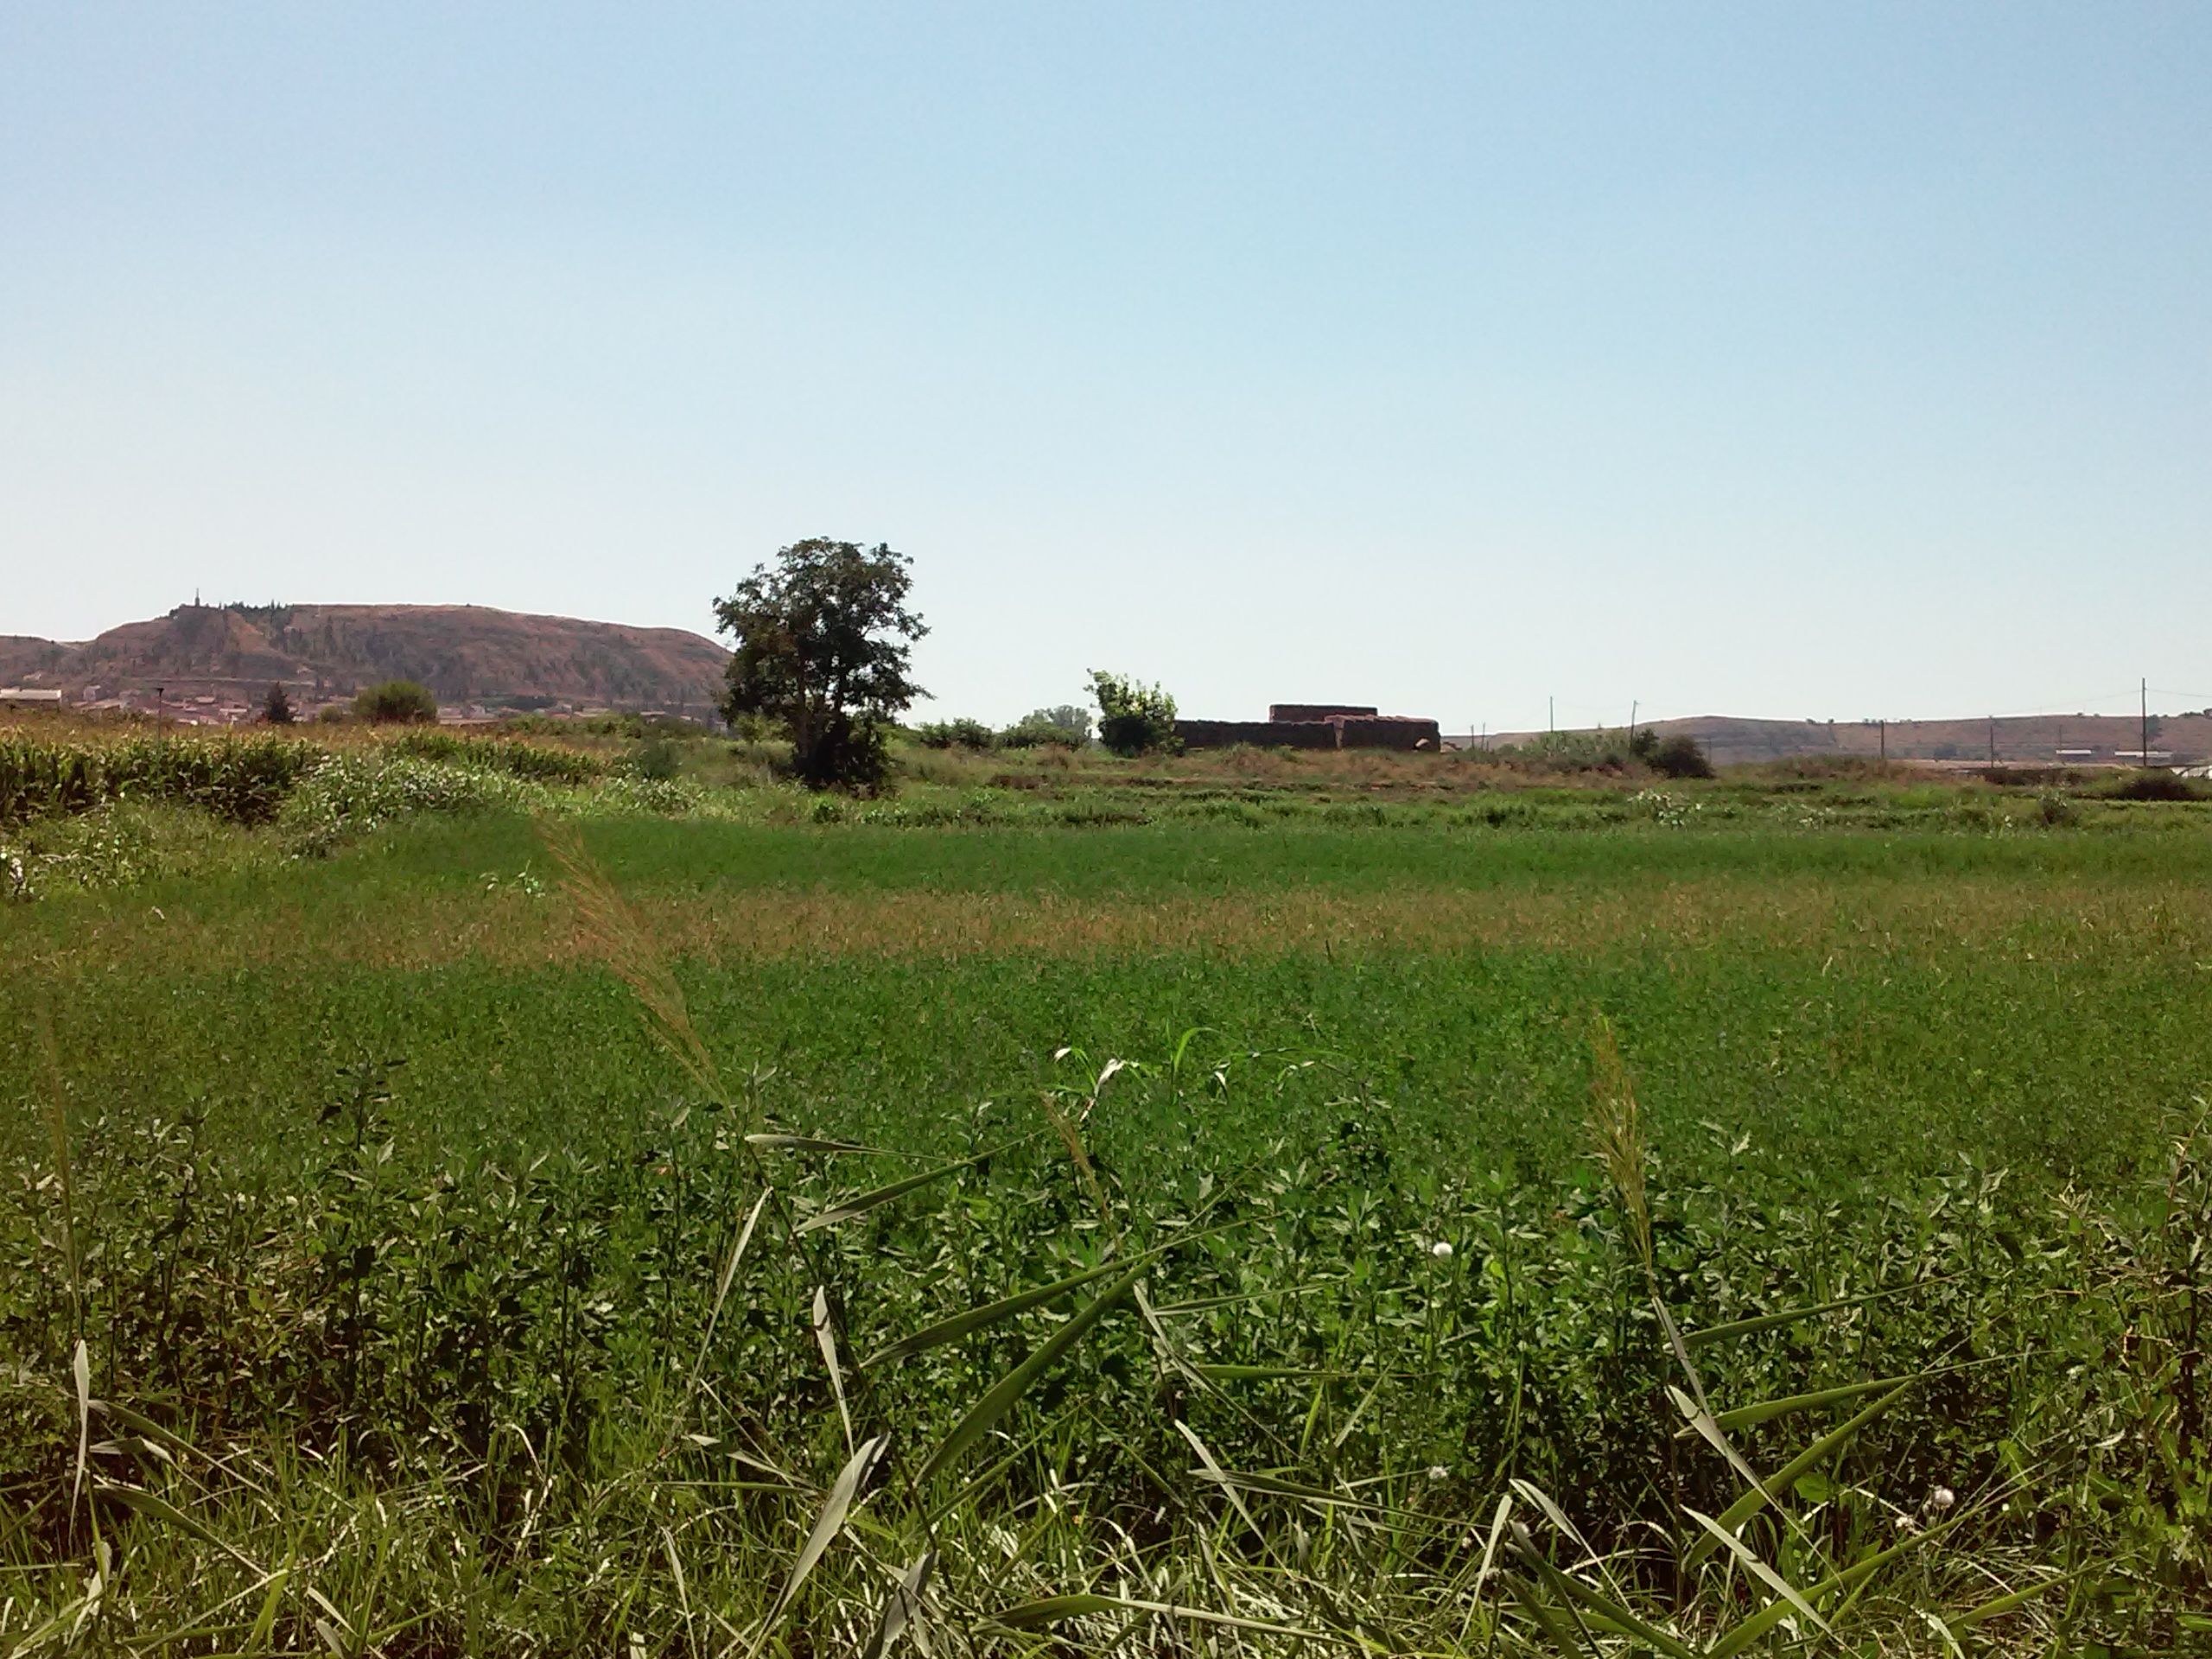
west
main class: Cropland
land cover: Common wheat
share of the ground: < 10 %
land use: Agriculture (excluding fallow land and kitchen gardens)
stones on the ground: 10 - 25 %
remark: Harvested field
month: July
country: ES
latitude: 41.7430
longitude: 0.5954
